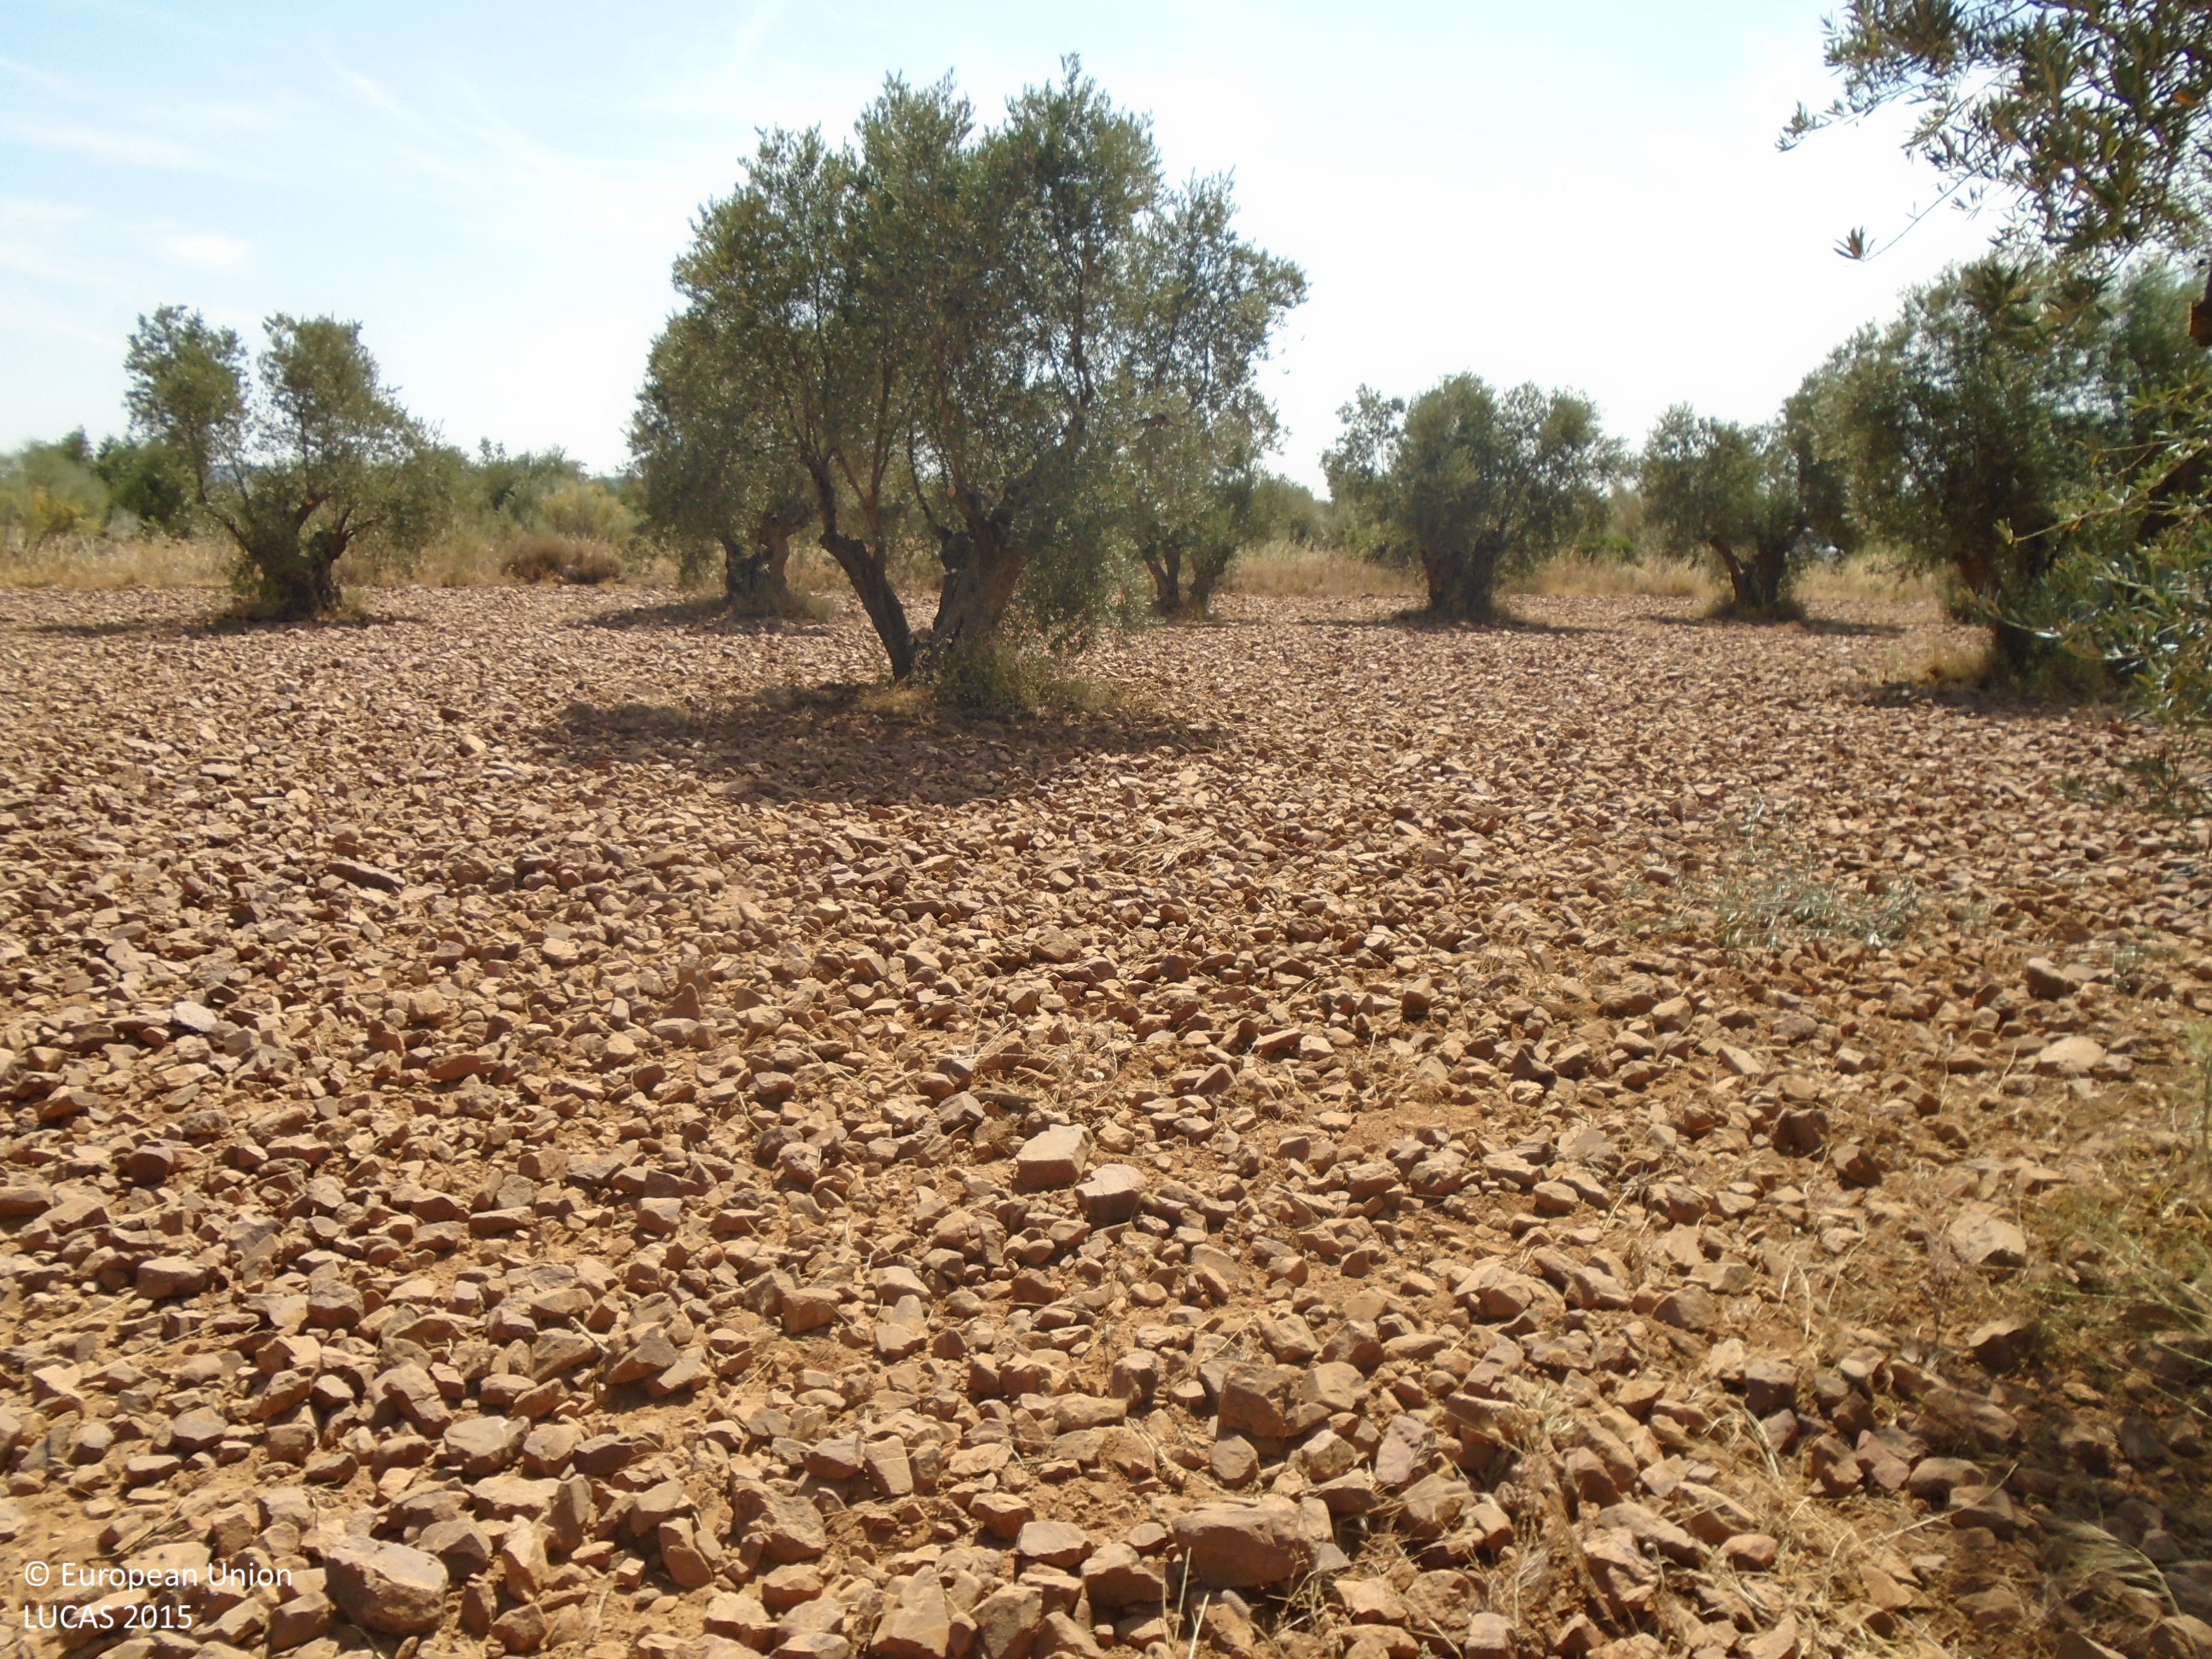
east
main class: Cropland
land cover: Olive groves
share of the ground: 25 - 50 %
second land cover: Other bare soil
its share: > 75 %
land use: Agriculture (excluding fallow land and kitchen gardens)
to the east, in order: Olive groves; Other bare soil; Grassland without tree/shrub cover; Ditches and canals; Grass margins; Tracks; Grass margins; Olive groves
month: June
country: ES
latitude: 39.2891
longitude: -3.5271
